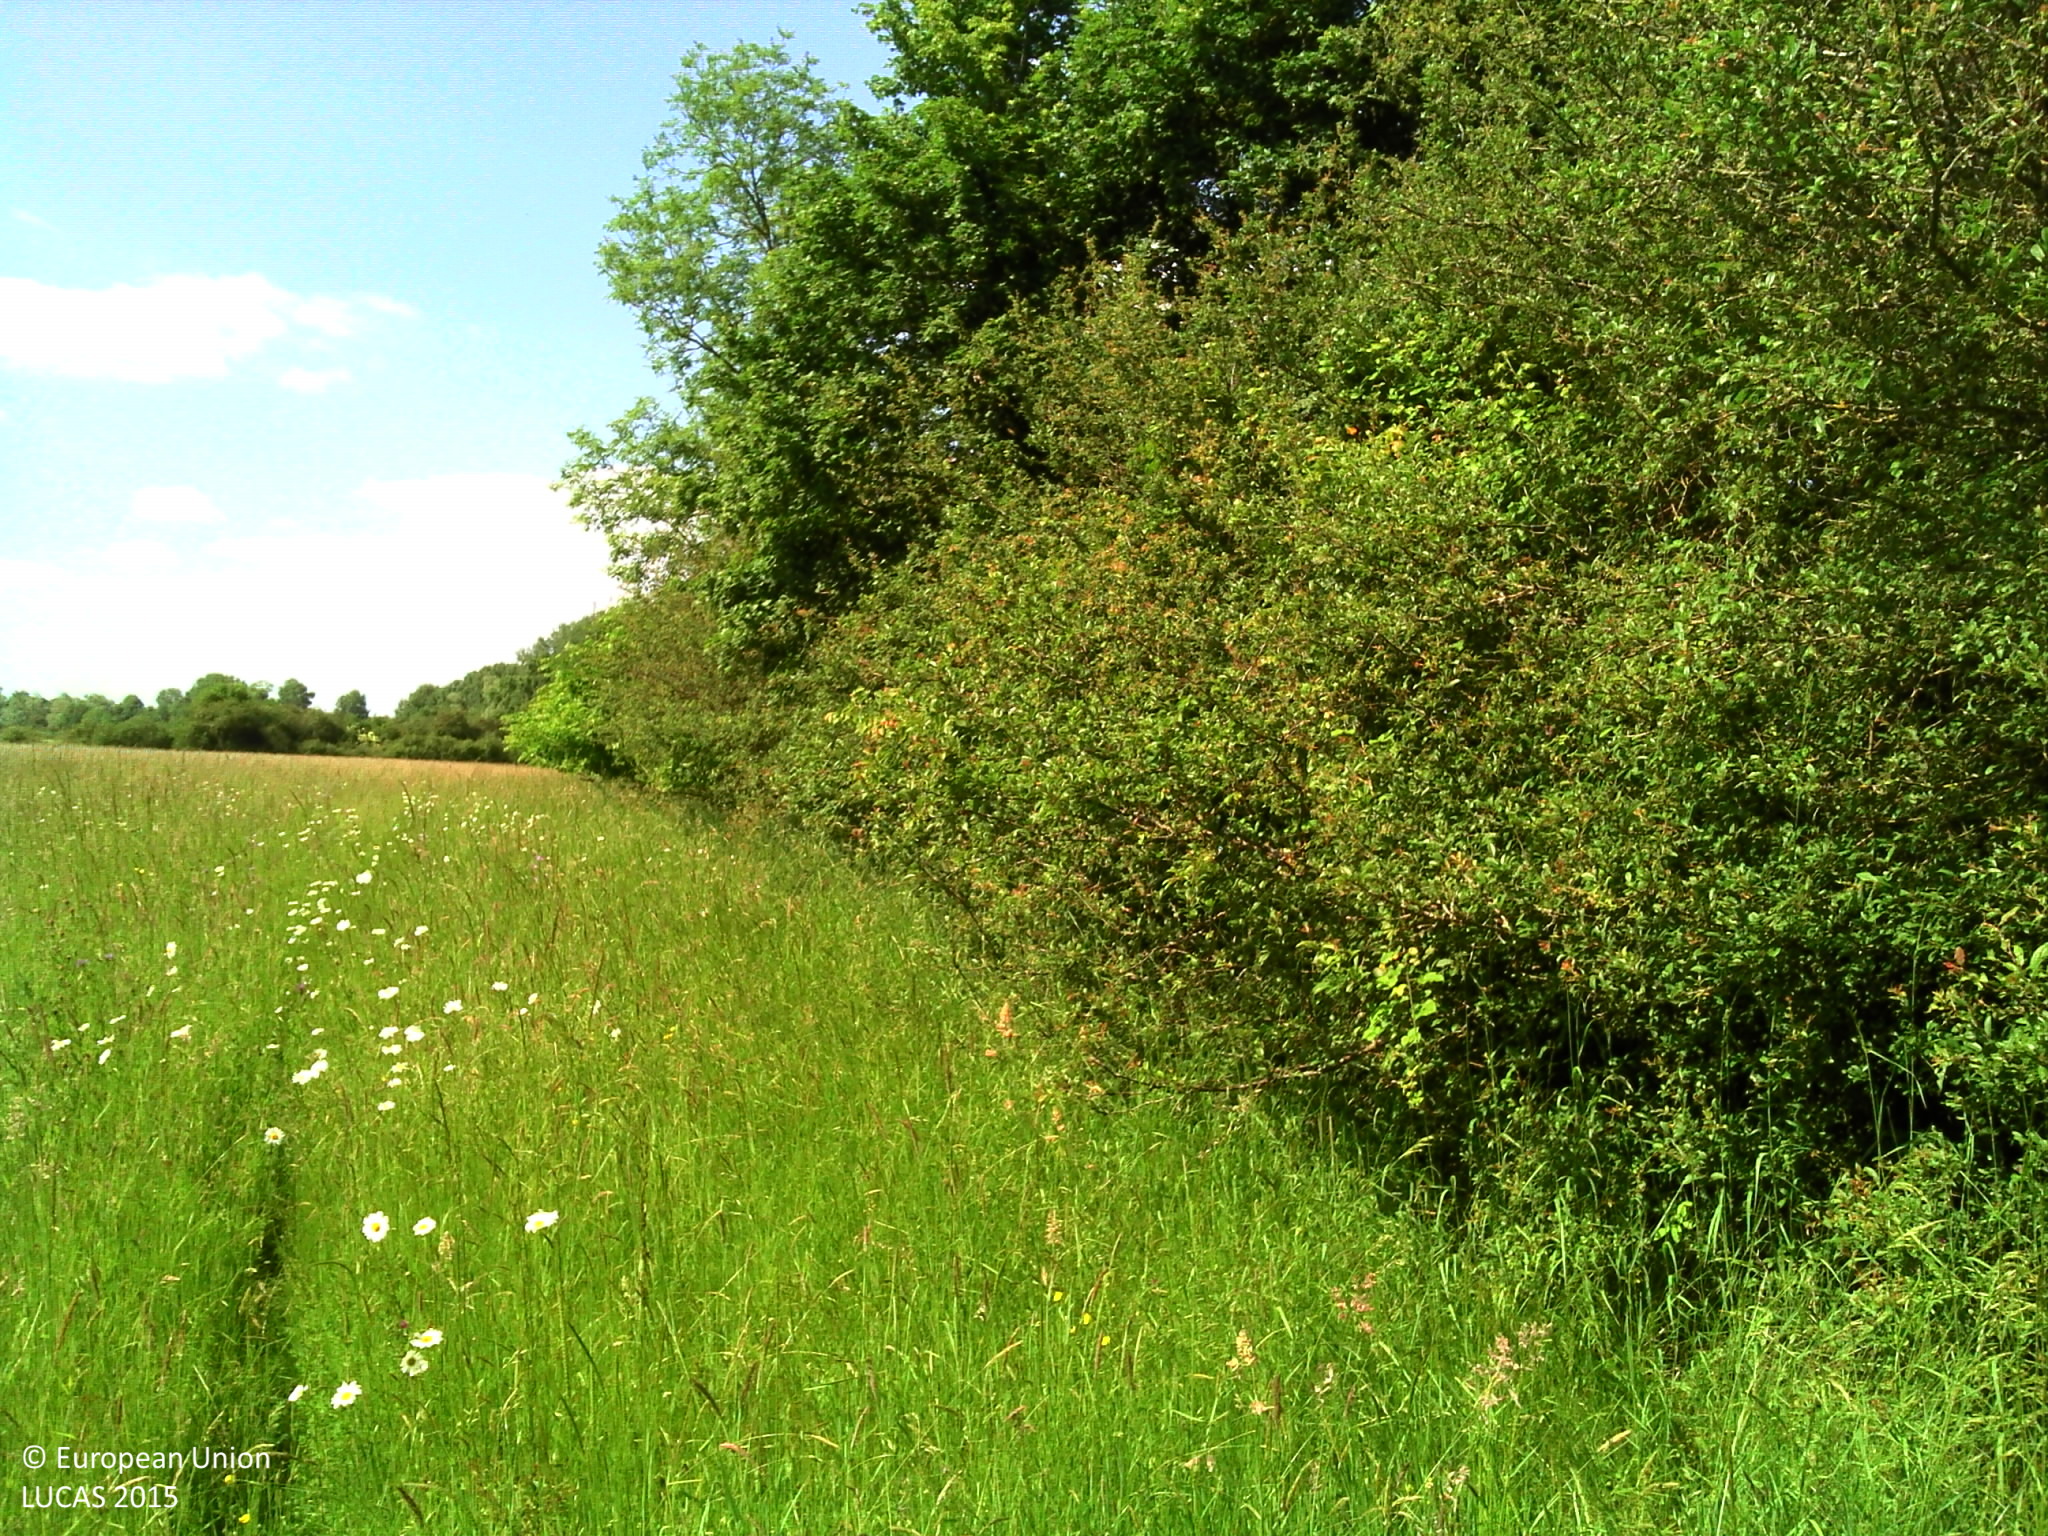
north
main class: Grassland
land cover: Grassland without tree/shrub cover
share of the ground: > 75 %
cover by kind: herbaceous plants 100 %
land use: Agriculture (excluding fallow land and kitchen gardens)
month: May
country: FR
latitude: 47.2912
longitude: 2.9202
